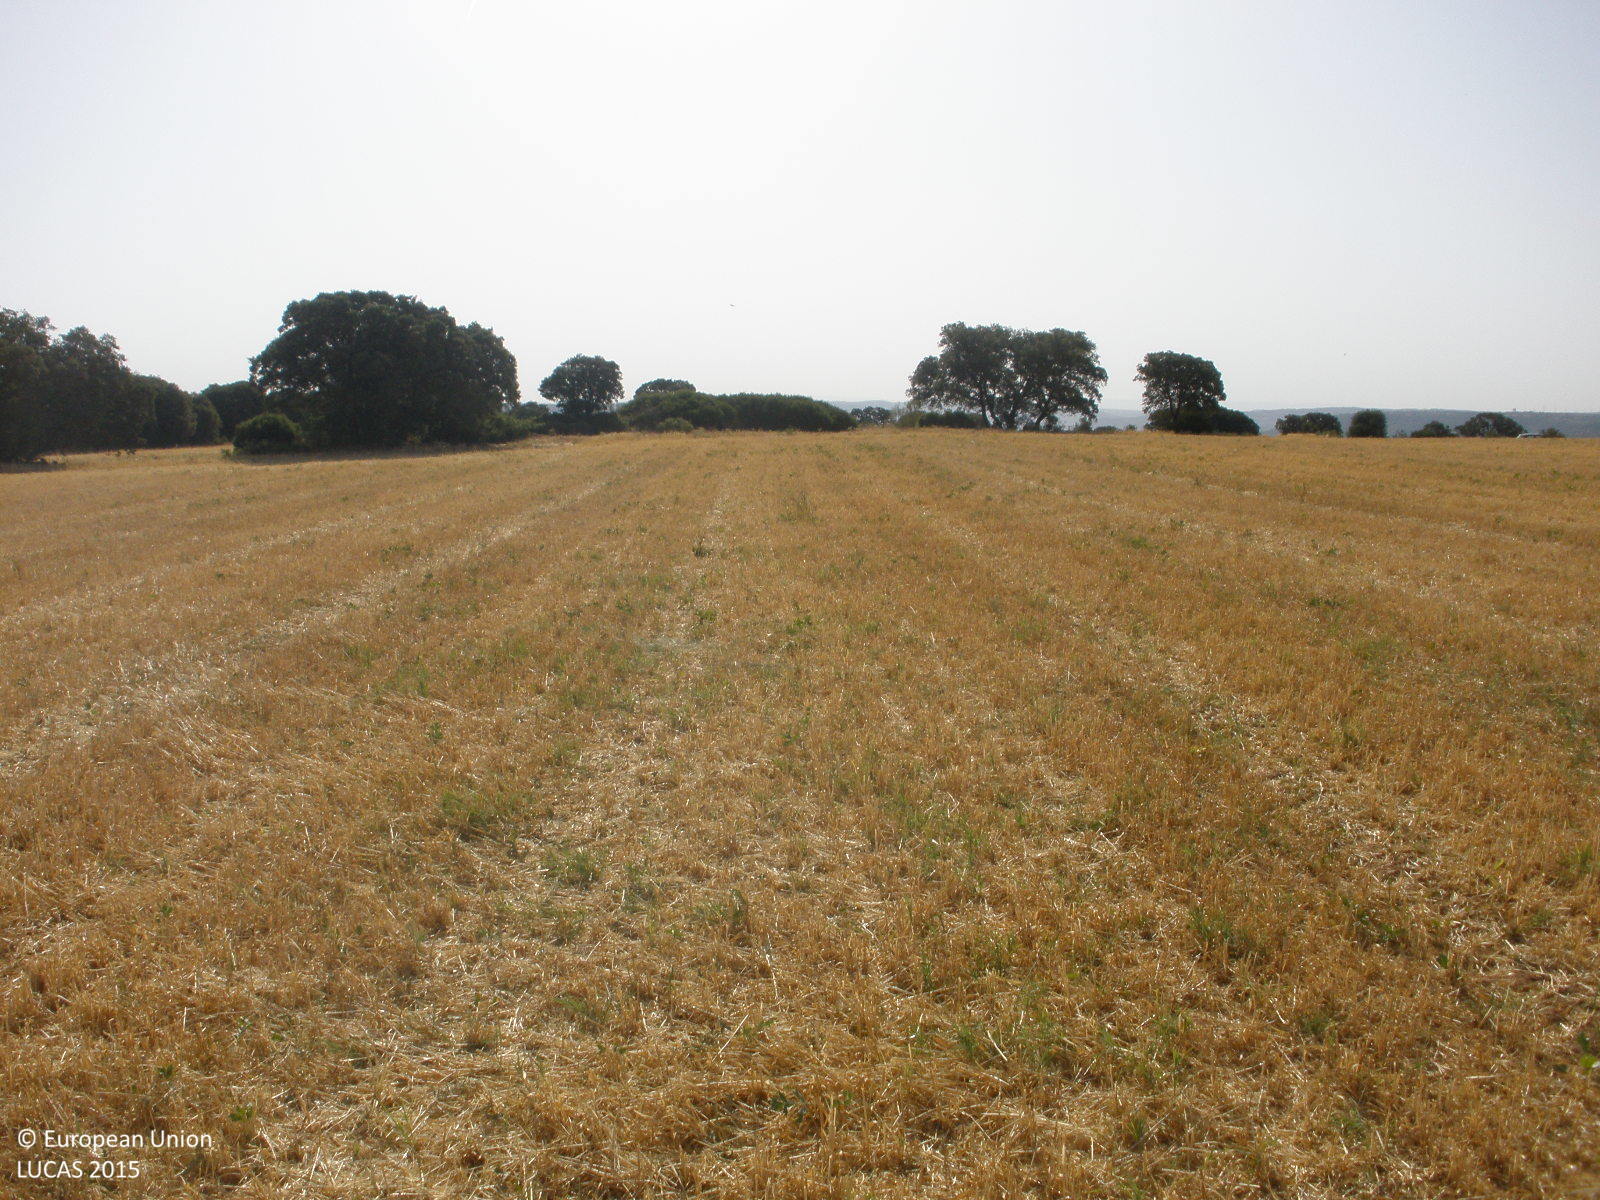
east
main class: Cropland
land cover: Barley
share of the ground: < 10 %
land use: Agriculture (excluding fallow land and kitchen gardens)
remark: Harvested field
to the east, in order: Barley; Broadleaved woodland; Barley; Lines of trees; Fences; Shruby margins; Tracks; Shruby margins; Fences; Grassland without tree/shrub cover; Broadleaved woodland
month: July
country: ES
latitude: 40.2507
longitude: -3.3271
